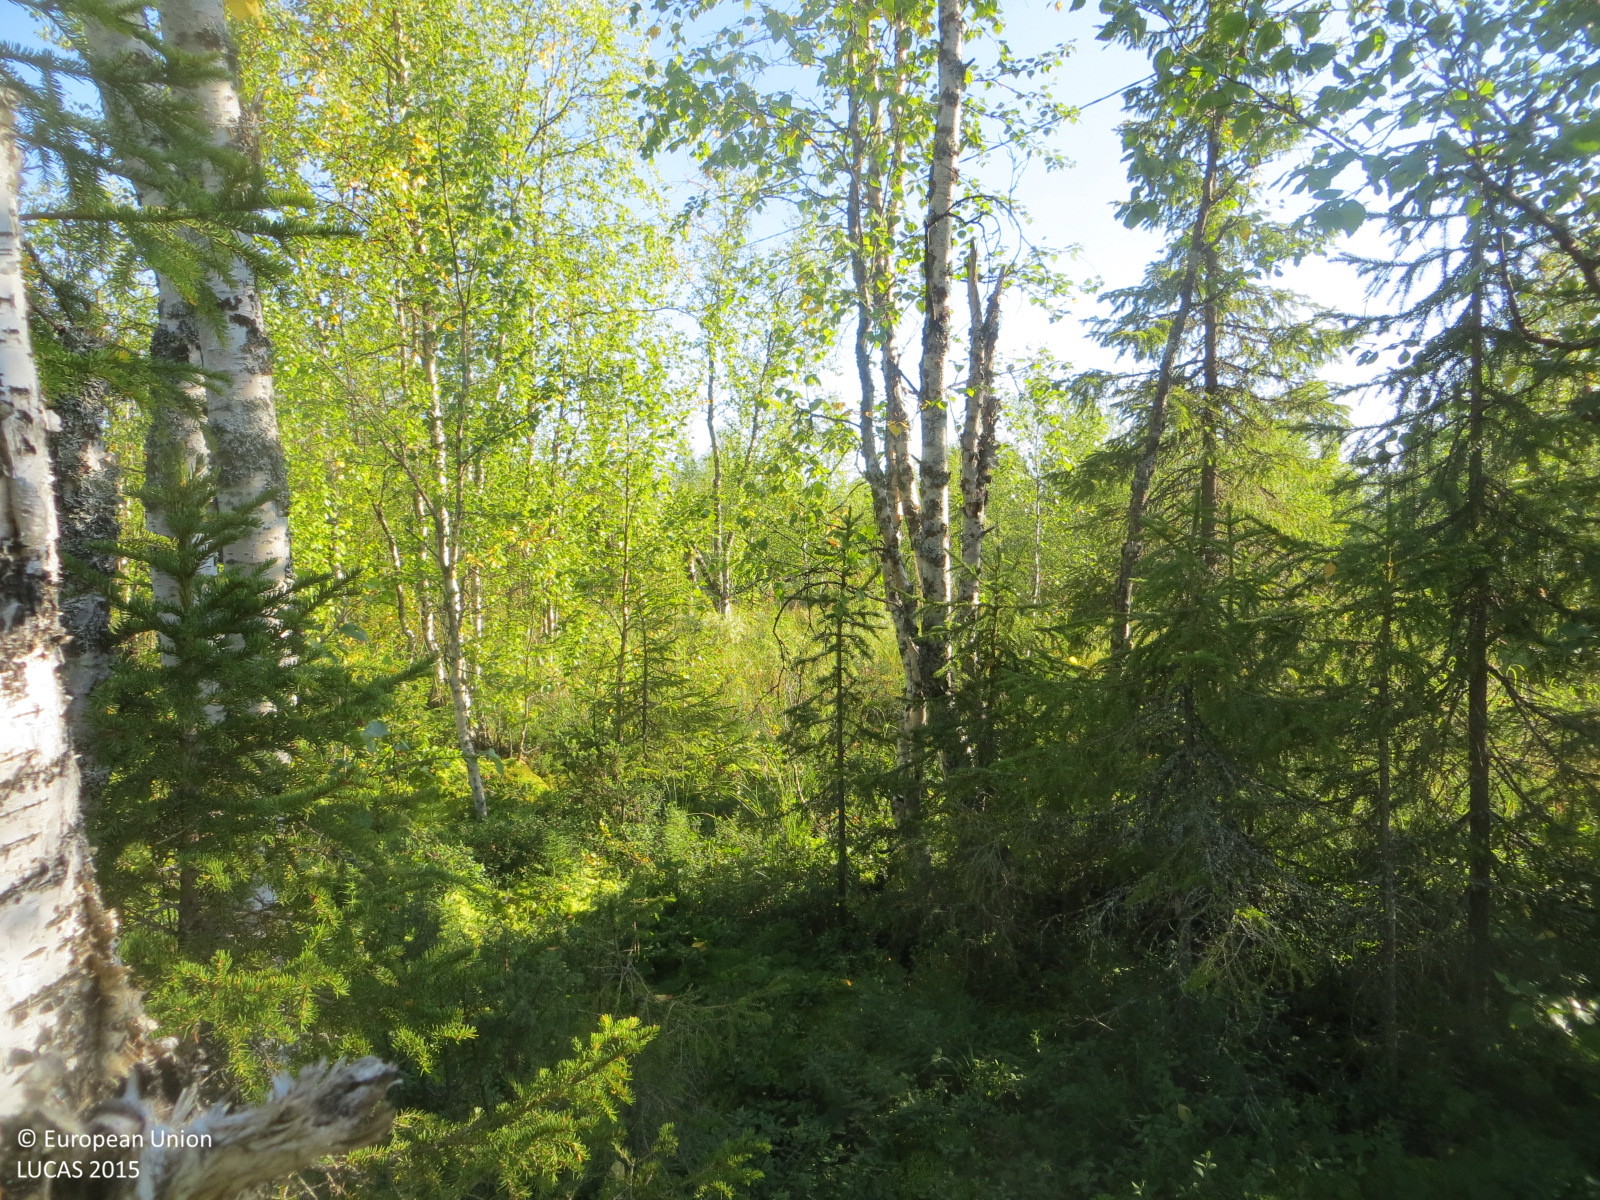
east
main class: Woodland
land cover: Spruce dominated mixed woodland
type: mire and swamp forests
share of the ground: 50 - 75 %
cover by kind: broadleaved forest trees 35 %, shrubs 35 %, coniferous forest trees 30 %
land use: Forestry
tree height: > 5 m
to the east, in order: Spruce dominated mixed woodland; Broadleaved woodland; Inland fresh running water; Broadleaved woodland
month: August
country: FI
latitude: 67.6148
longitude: 24.1654
